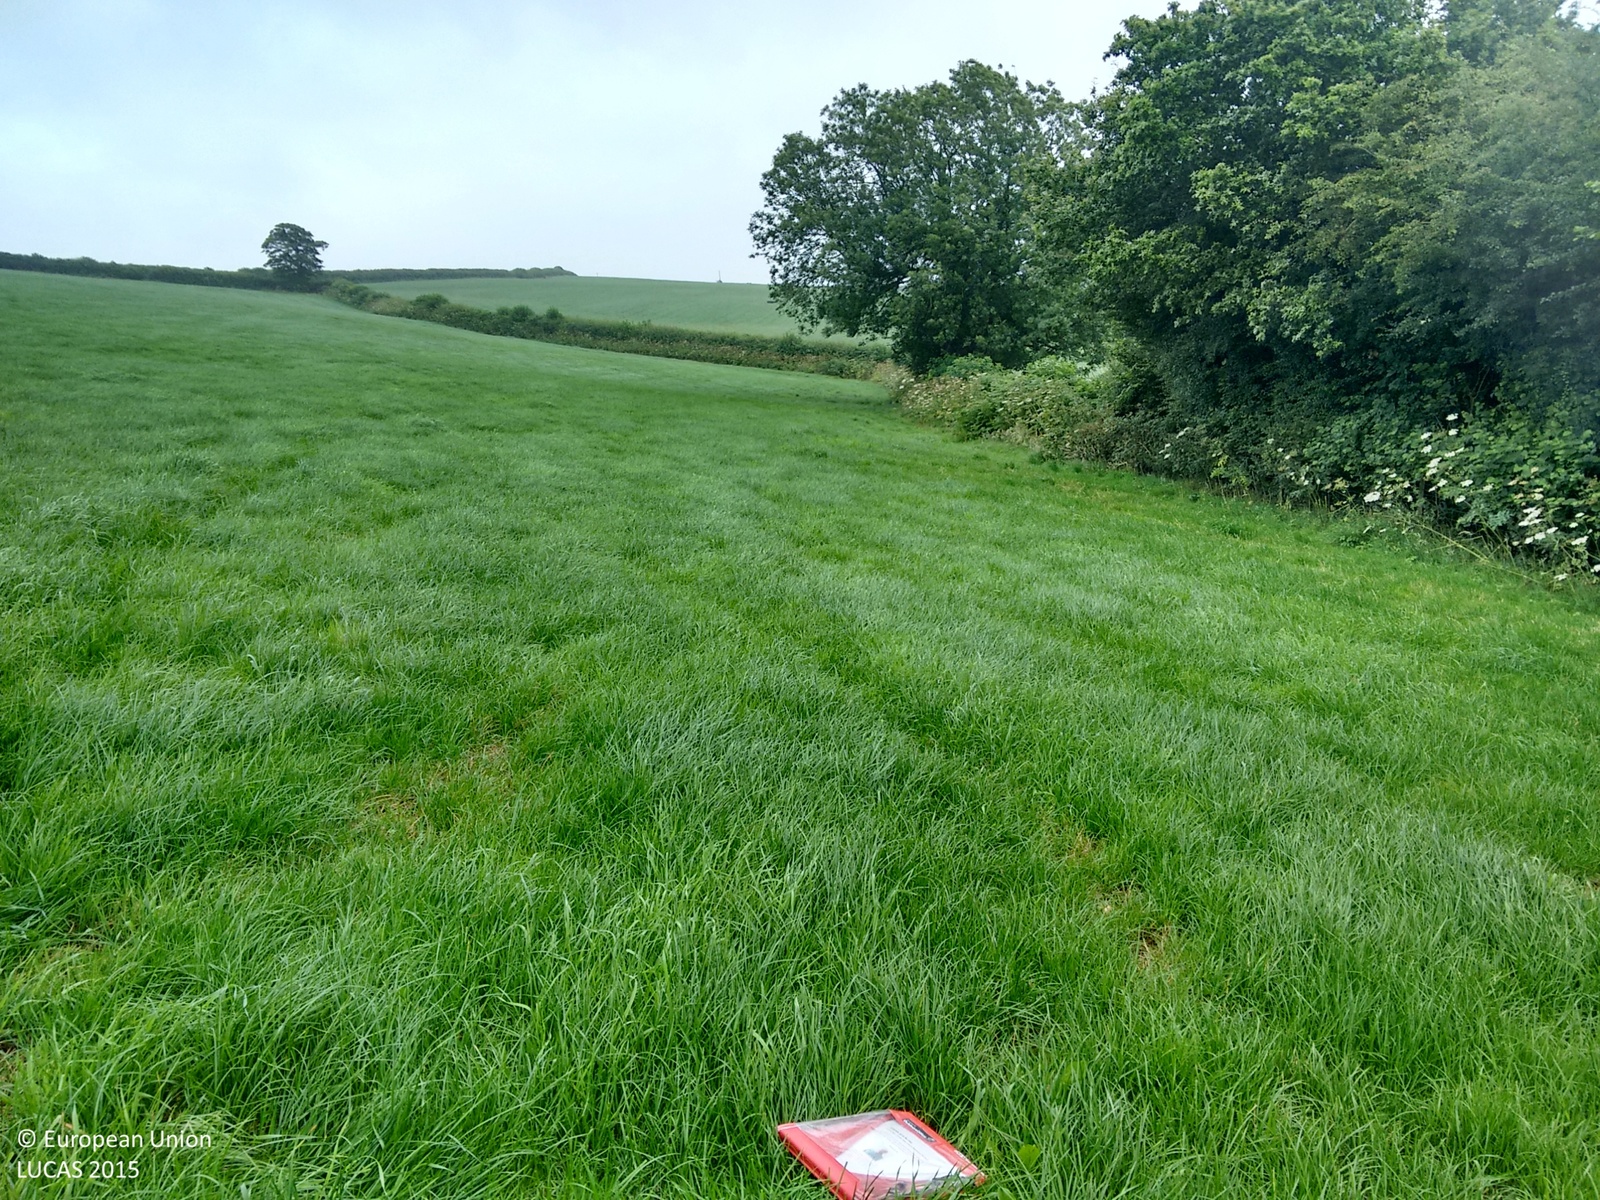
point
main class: Cropland
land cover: Temporary grasslands
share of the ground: > 75 %
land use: Agriculture (excluding fallow land and kitchen gardens)
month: August
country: GB
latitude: 51.8580
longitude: -4.4054
